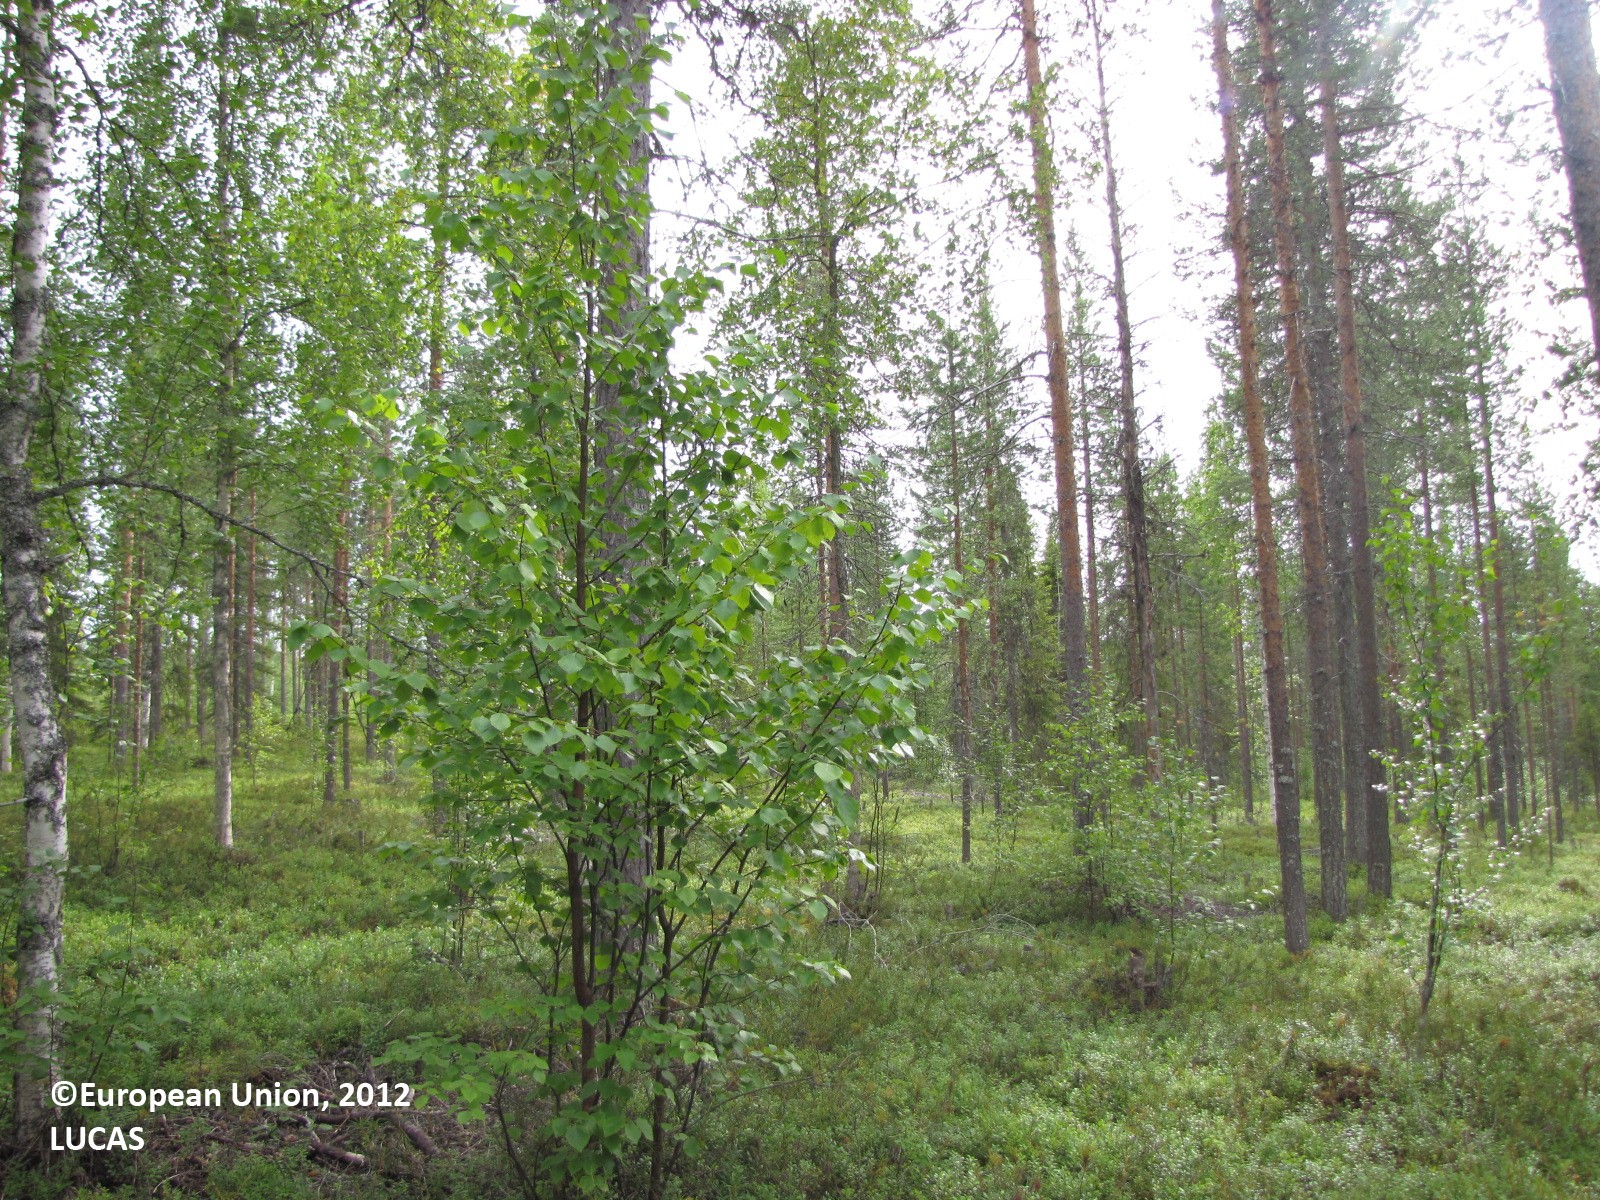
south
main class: Woodland
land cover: Other mixed woodland
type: boreal forest
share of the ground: 10 - 25 %
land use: Forestry
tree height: > 5 m
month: August
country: FI
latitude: 66.8508
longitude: 24.8863
